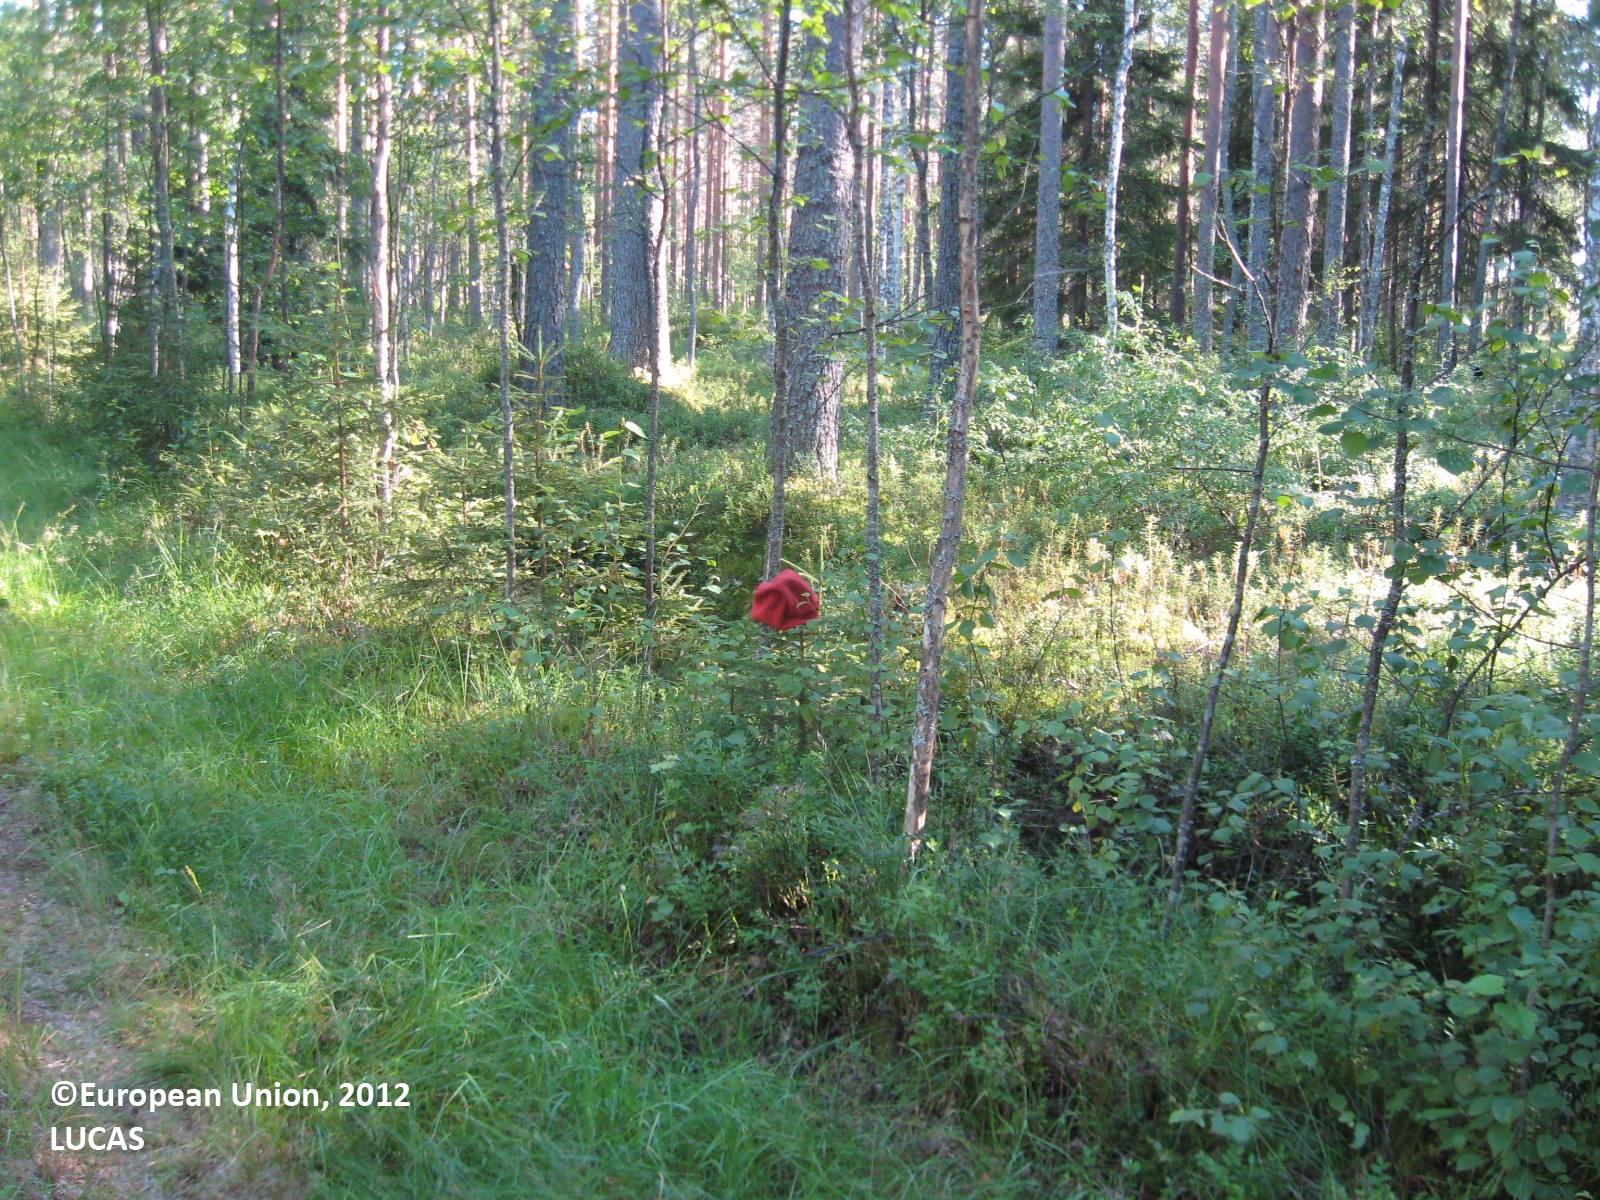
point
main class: Woodland
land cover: Pine dominated mixed woodland
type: boreal forest
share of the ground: > 75 %
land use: Forestry
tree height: > 5 m
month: July
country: FI
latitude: 62.0579
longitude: 22.4355
